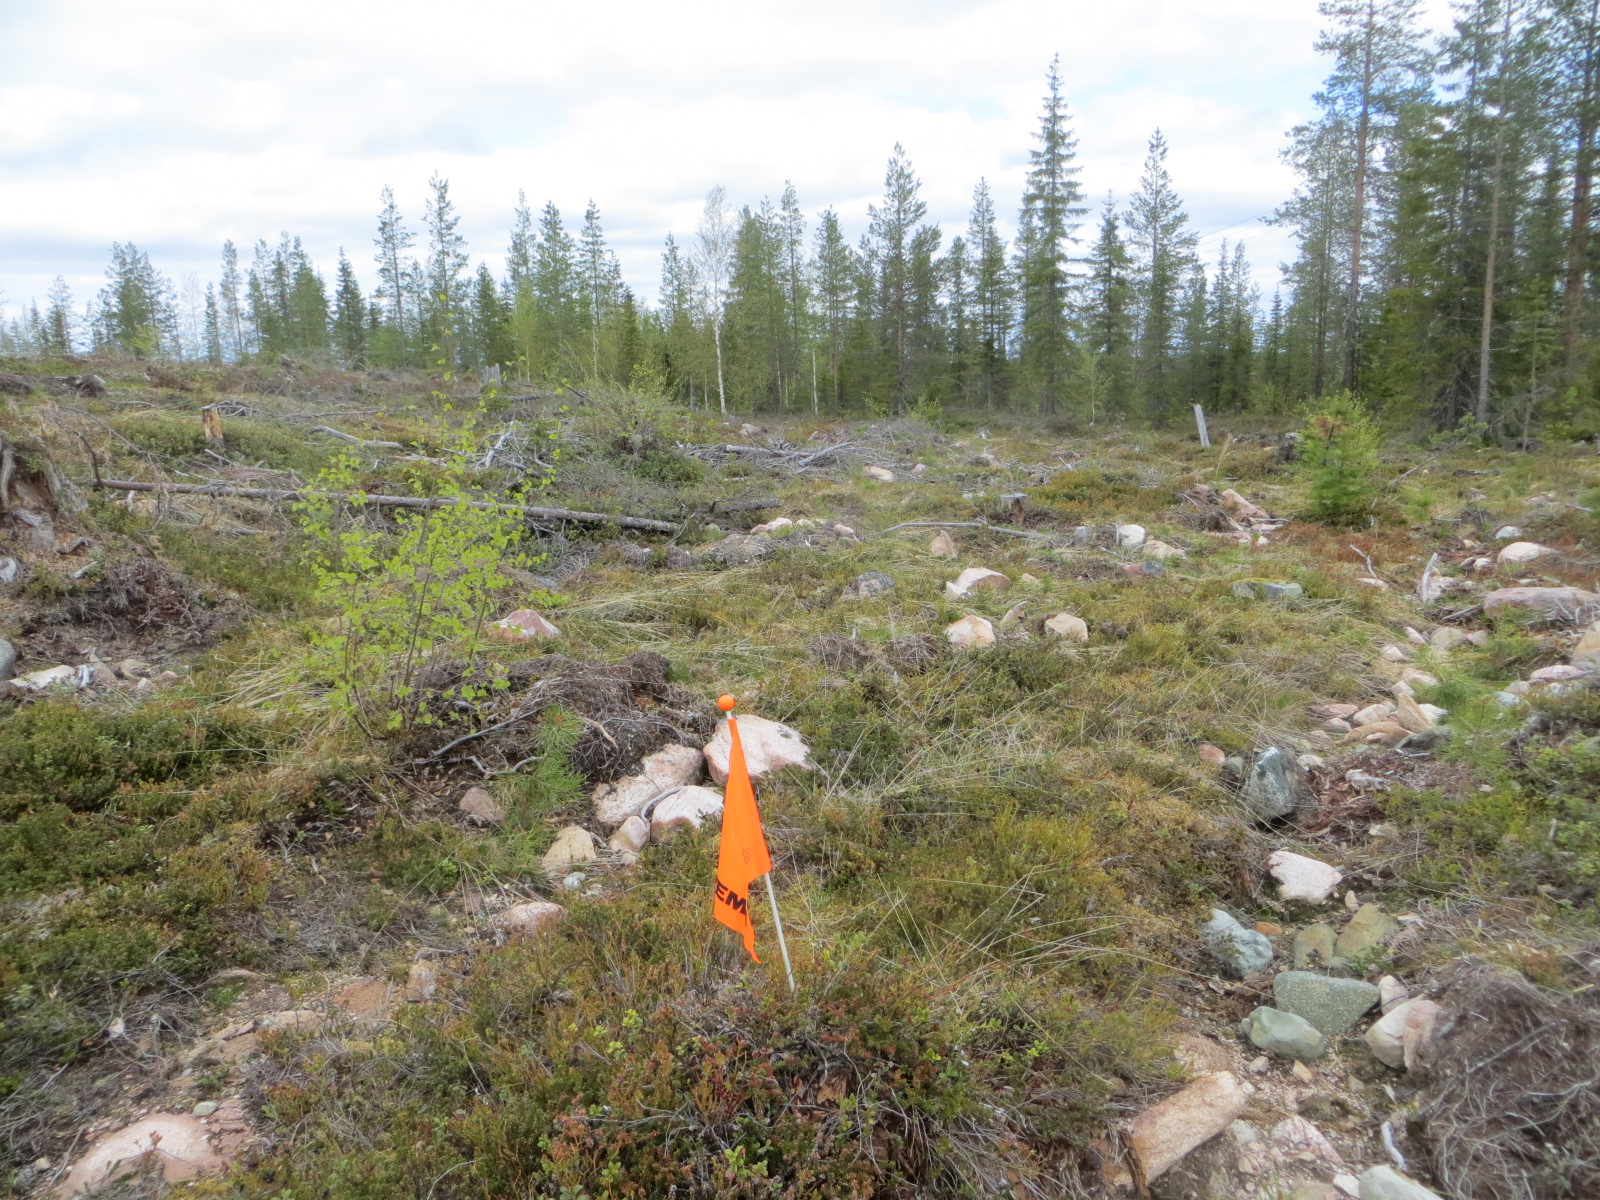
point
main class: Shrubland
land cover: Shrubland with sparse tree cover
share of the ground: > 75 %
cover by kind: shrubs 70 %, herbaceous plants 10 %, unconsolidated bare surface 10 %, coniferous forest trees 5 %, lichens and mosses 5 %
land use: Forestry
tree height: < 5 m
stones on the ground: 25 - 50 %
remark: Clear cut
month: June
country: FI
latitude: 67.6072
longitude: 24.9262
